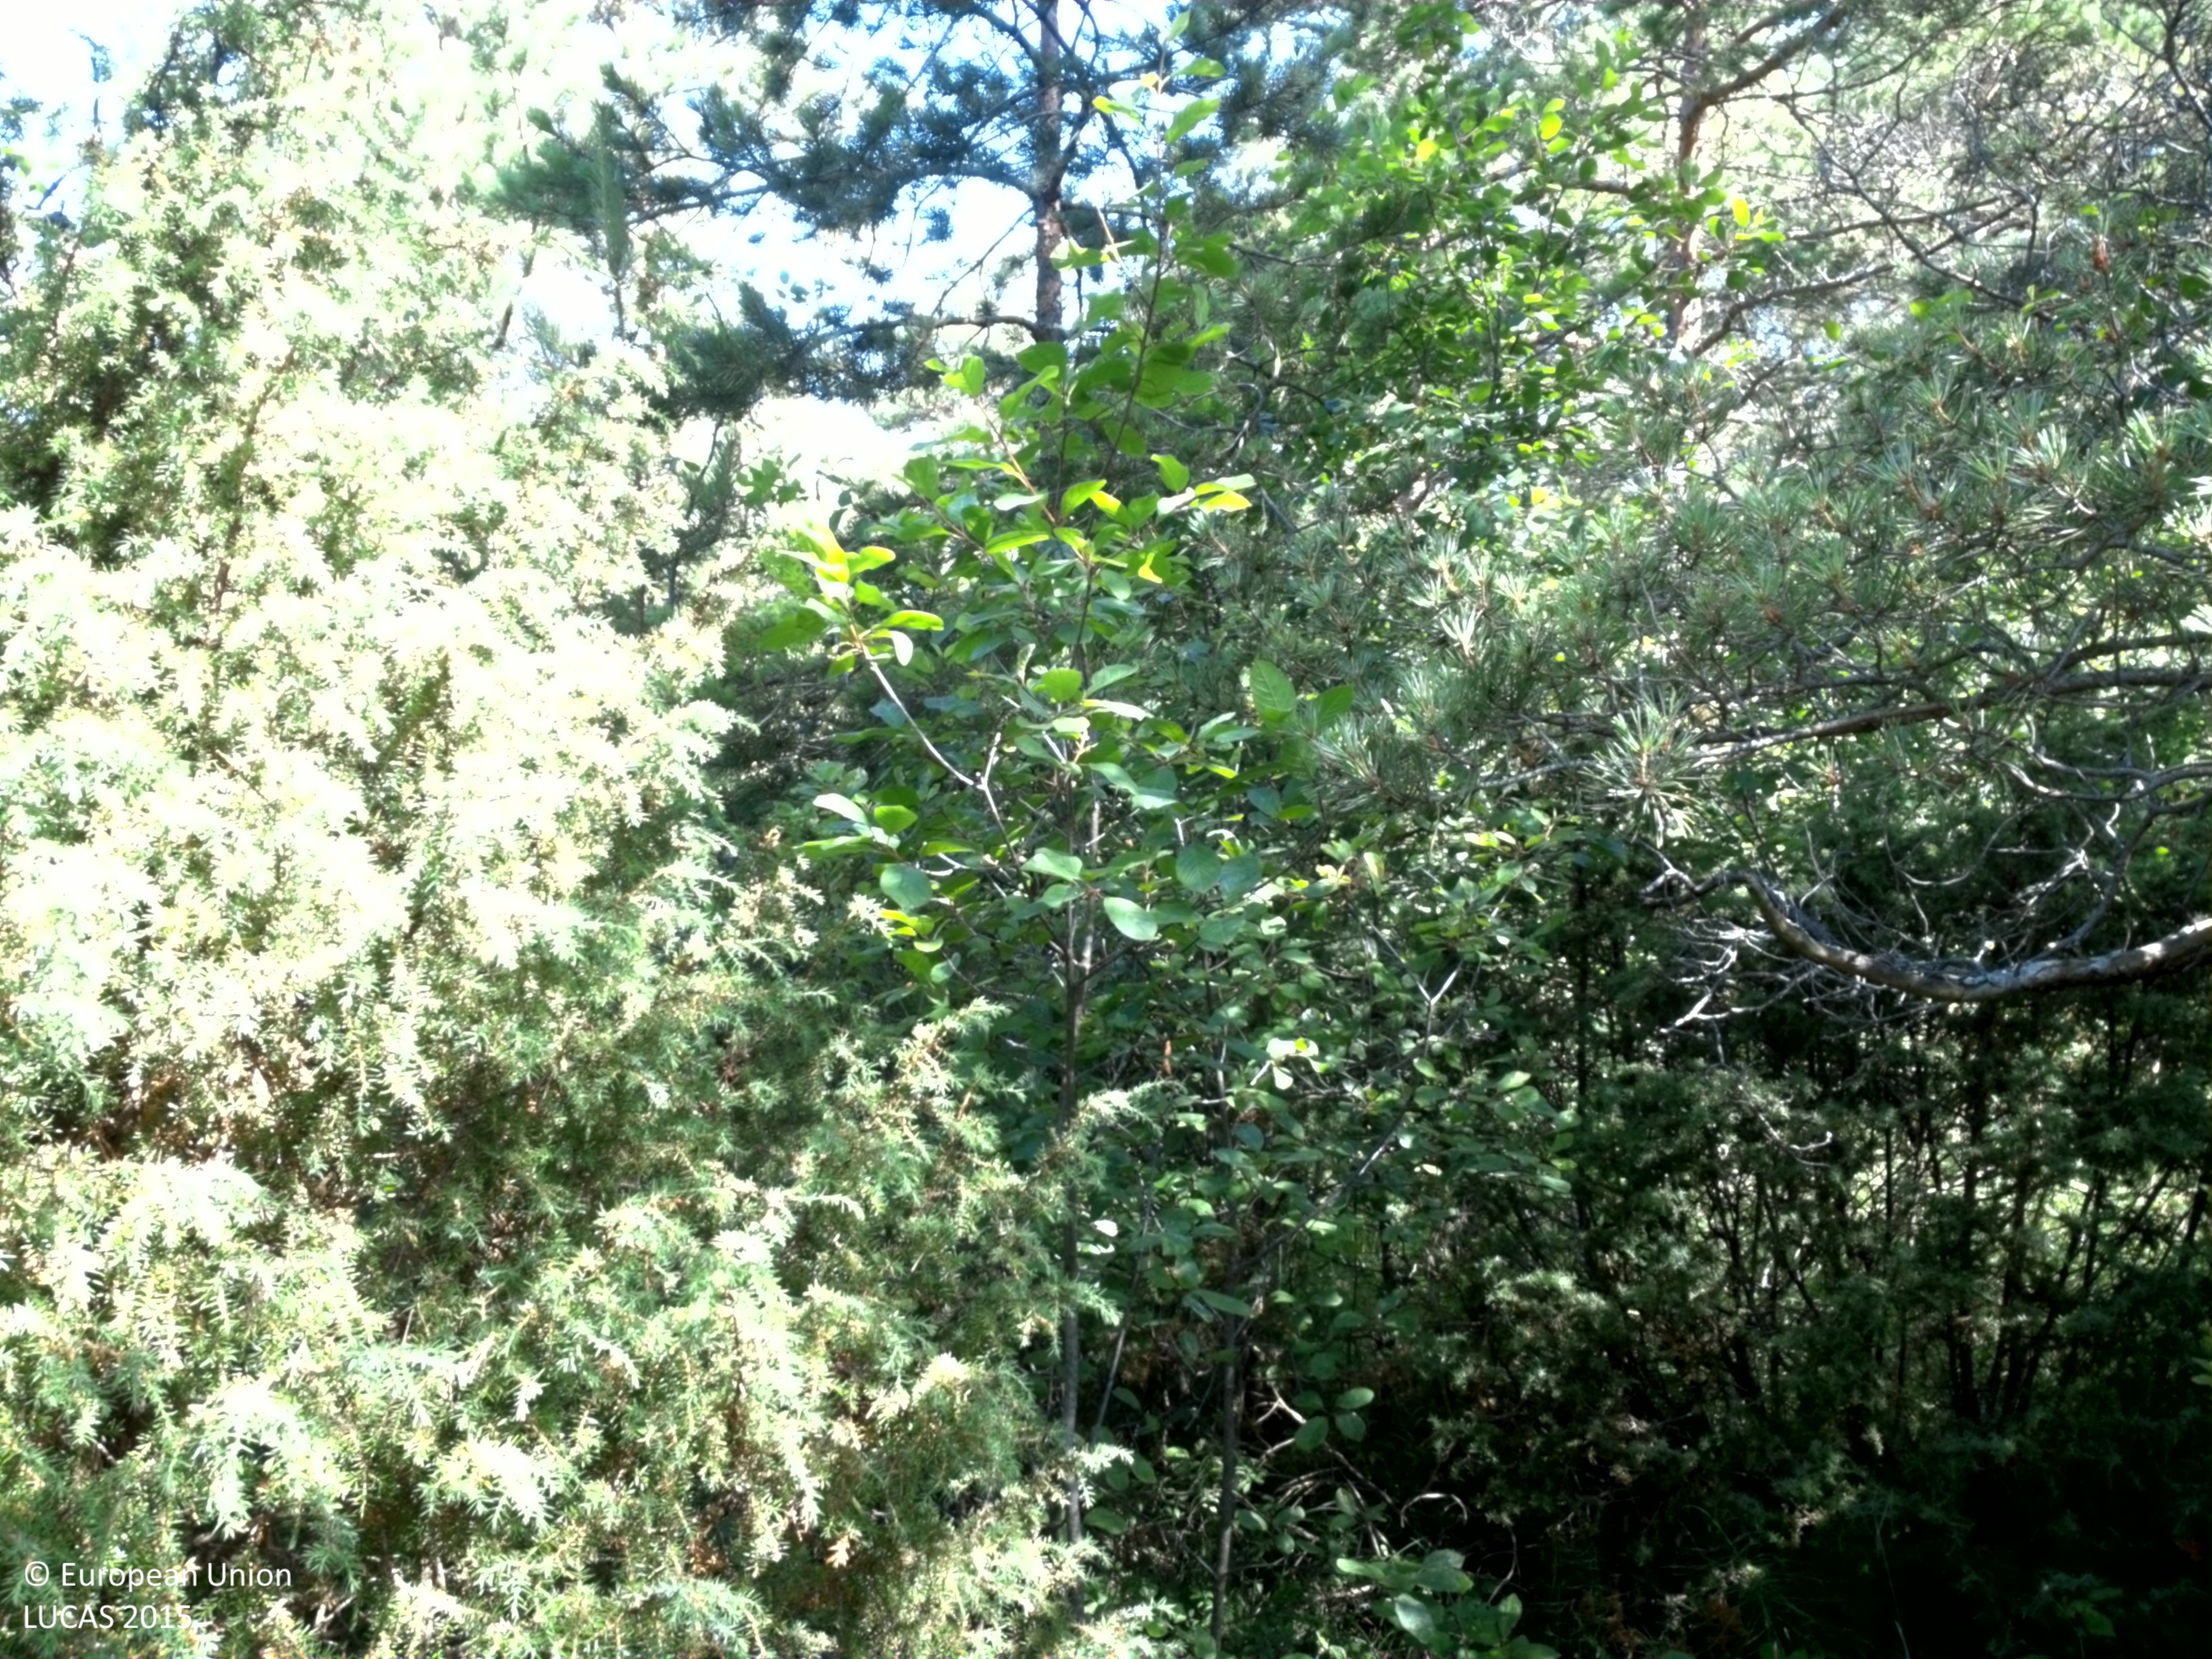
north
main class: Woodland
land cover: Pine dominated mixed woodland
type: hemiboreal forest and nemoral coniferous forest and mixed broadleaved-coniferous forest
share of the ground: > 75 %
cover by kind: coniferous forest trees 55 %, broadleaved forest trees 20 %, herbaceous plants 15 %, shrubs 10 %
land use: Forestry
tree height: > 5 m
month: July
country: SE
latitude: 57.2089
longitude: 18.2028
